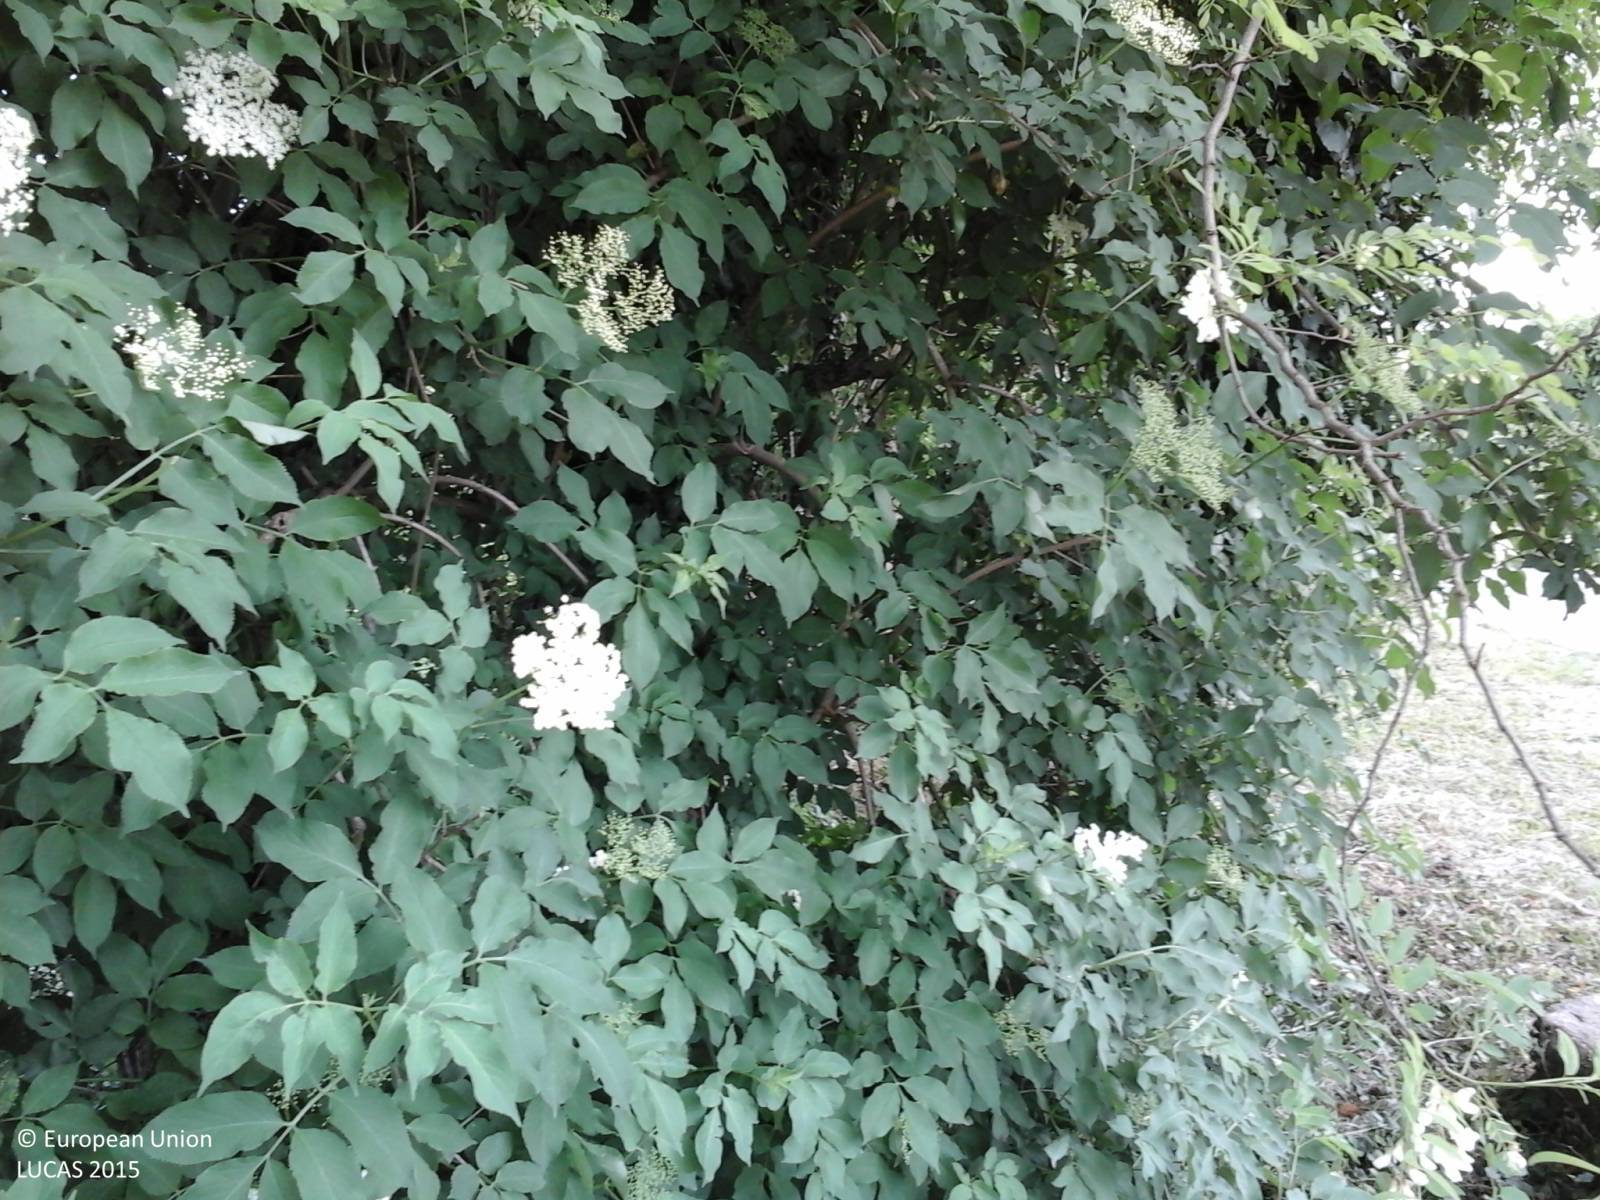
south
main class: Woodland
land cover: Broadleaved woodland
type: mesophytic deciduous forest
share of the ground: > 75 %
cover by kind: broadleaved forest trees 60 %, shrubs 25 %, herbaceous plants 15 %
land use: Forestry
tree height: > 5 m
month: May
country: IT
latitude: 46.2200
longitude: 12.9655
